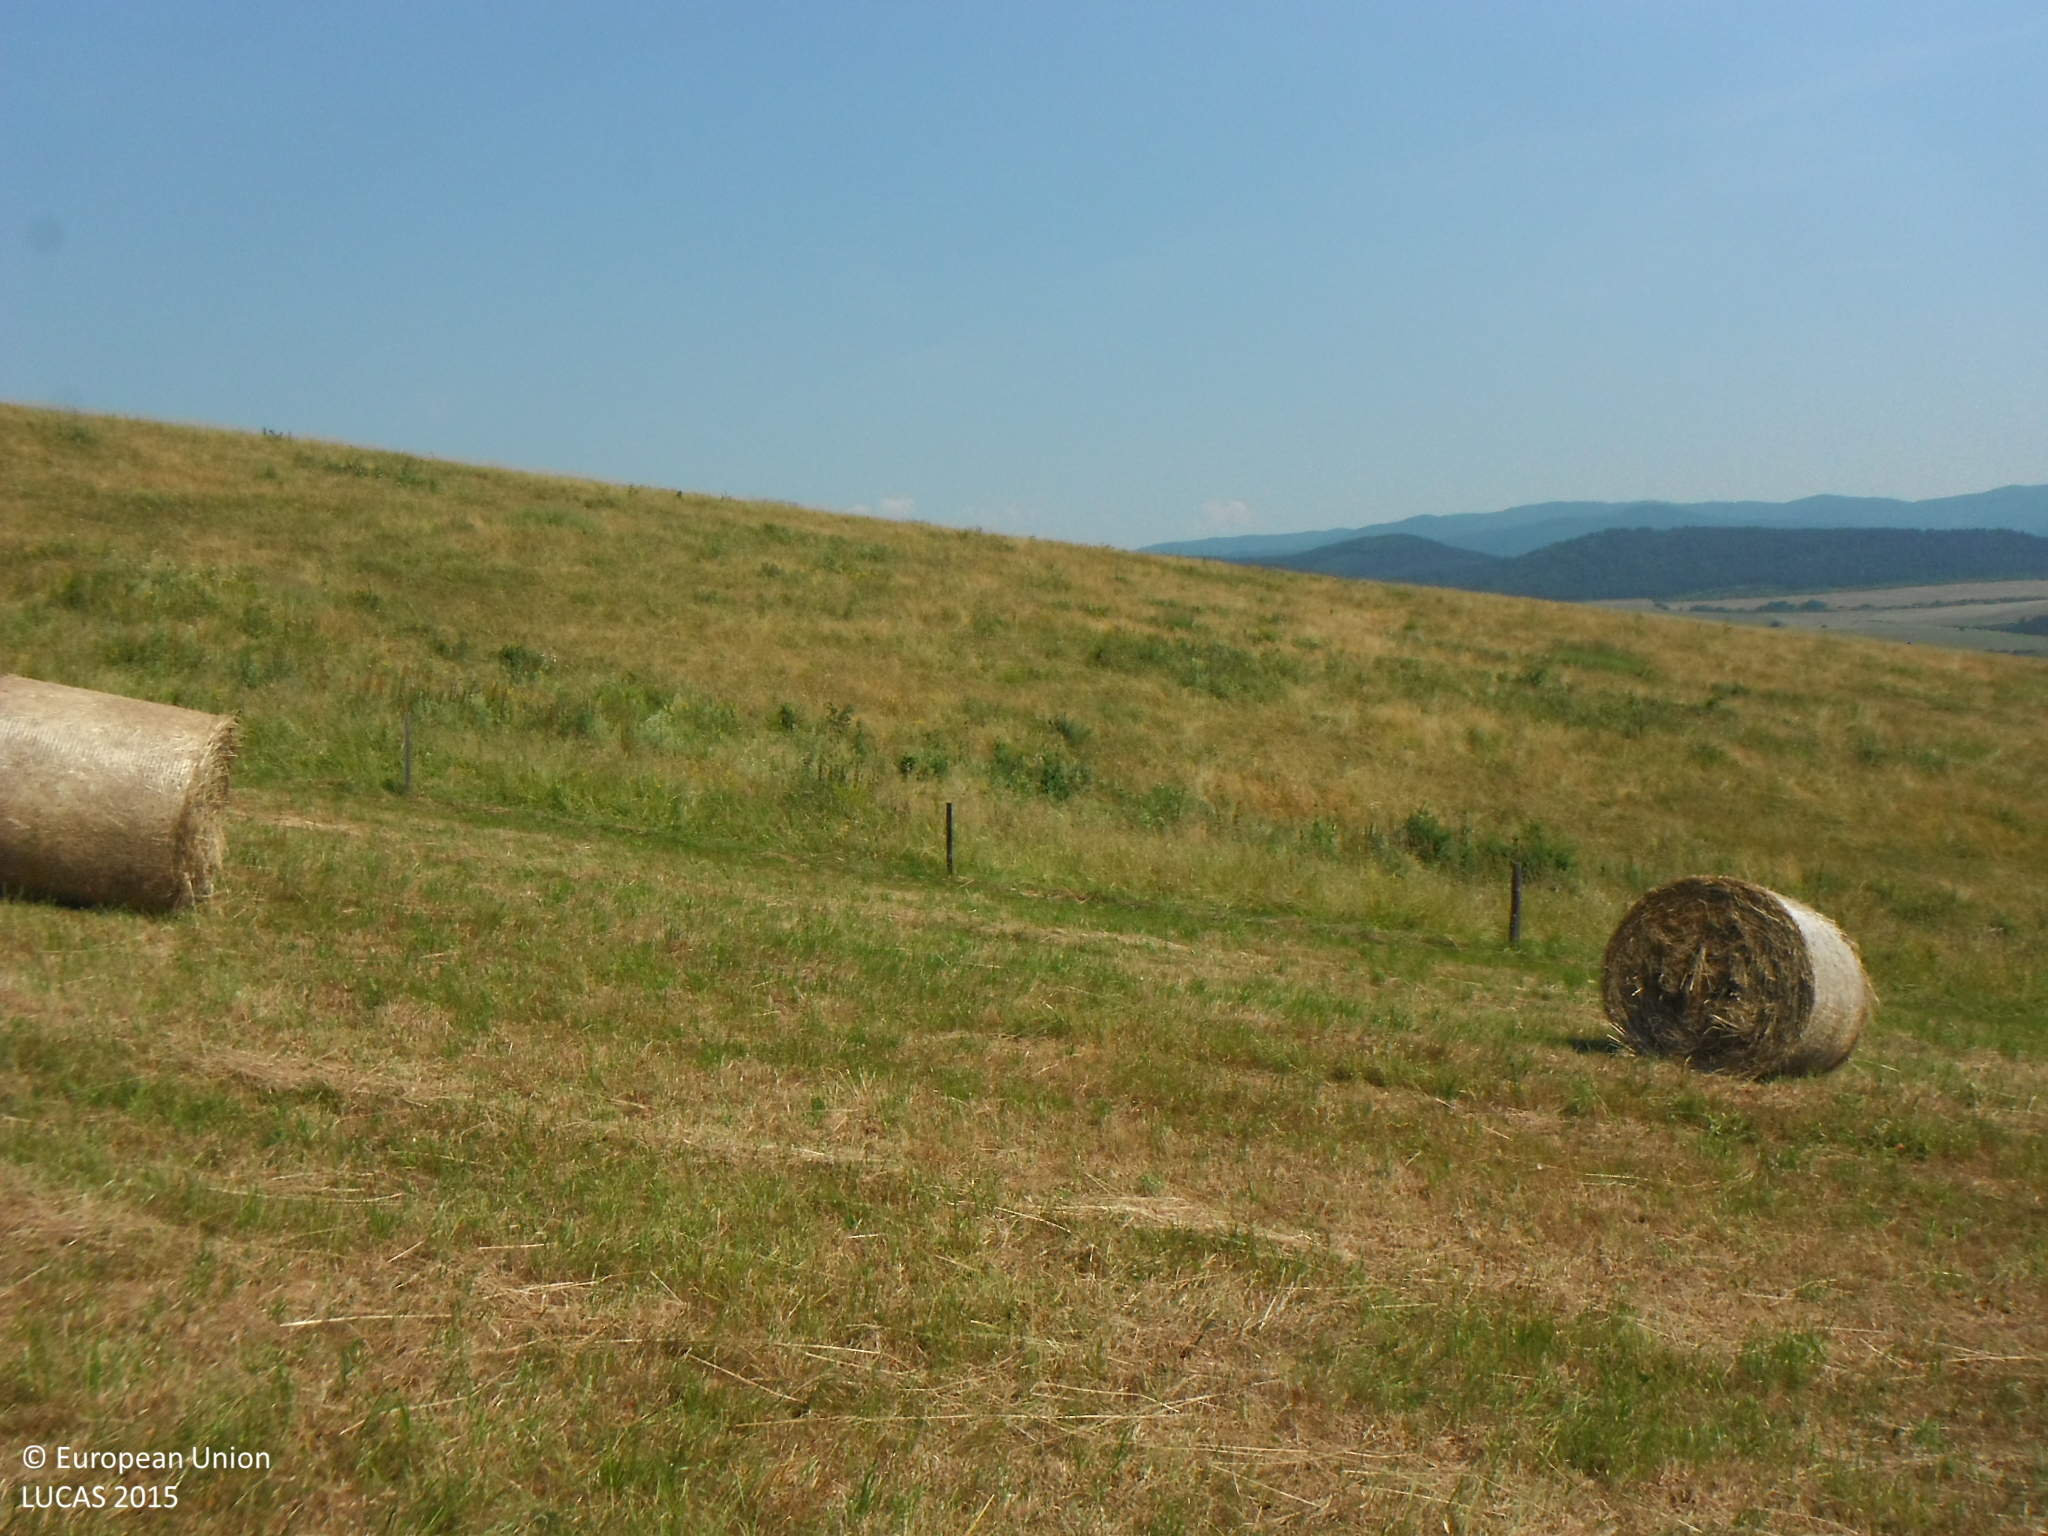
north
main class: Grassland
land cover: Grassland without tree/shrub cover
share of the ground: > 75 %
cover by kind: herbaceous plants 100 %
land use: Agriculture (excluding fallow land and kitchen gardens)
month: July
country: SK
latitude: 49.1504
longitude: 20.9135
